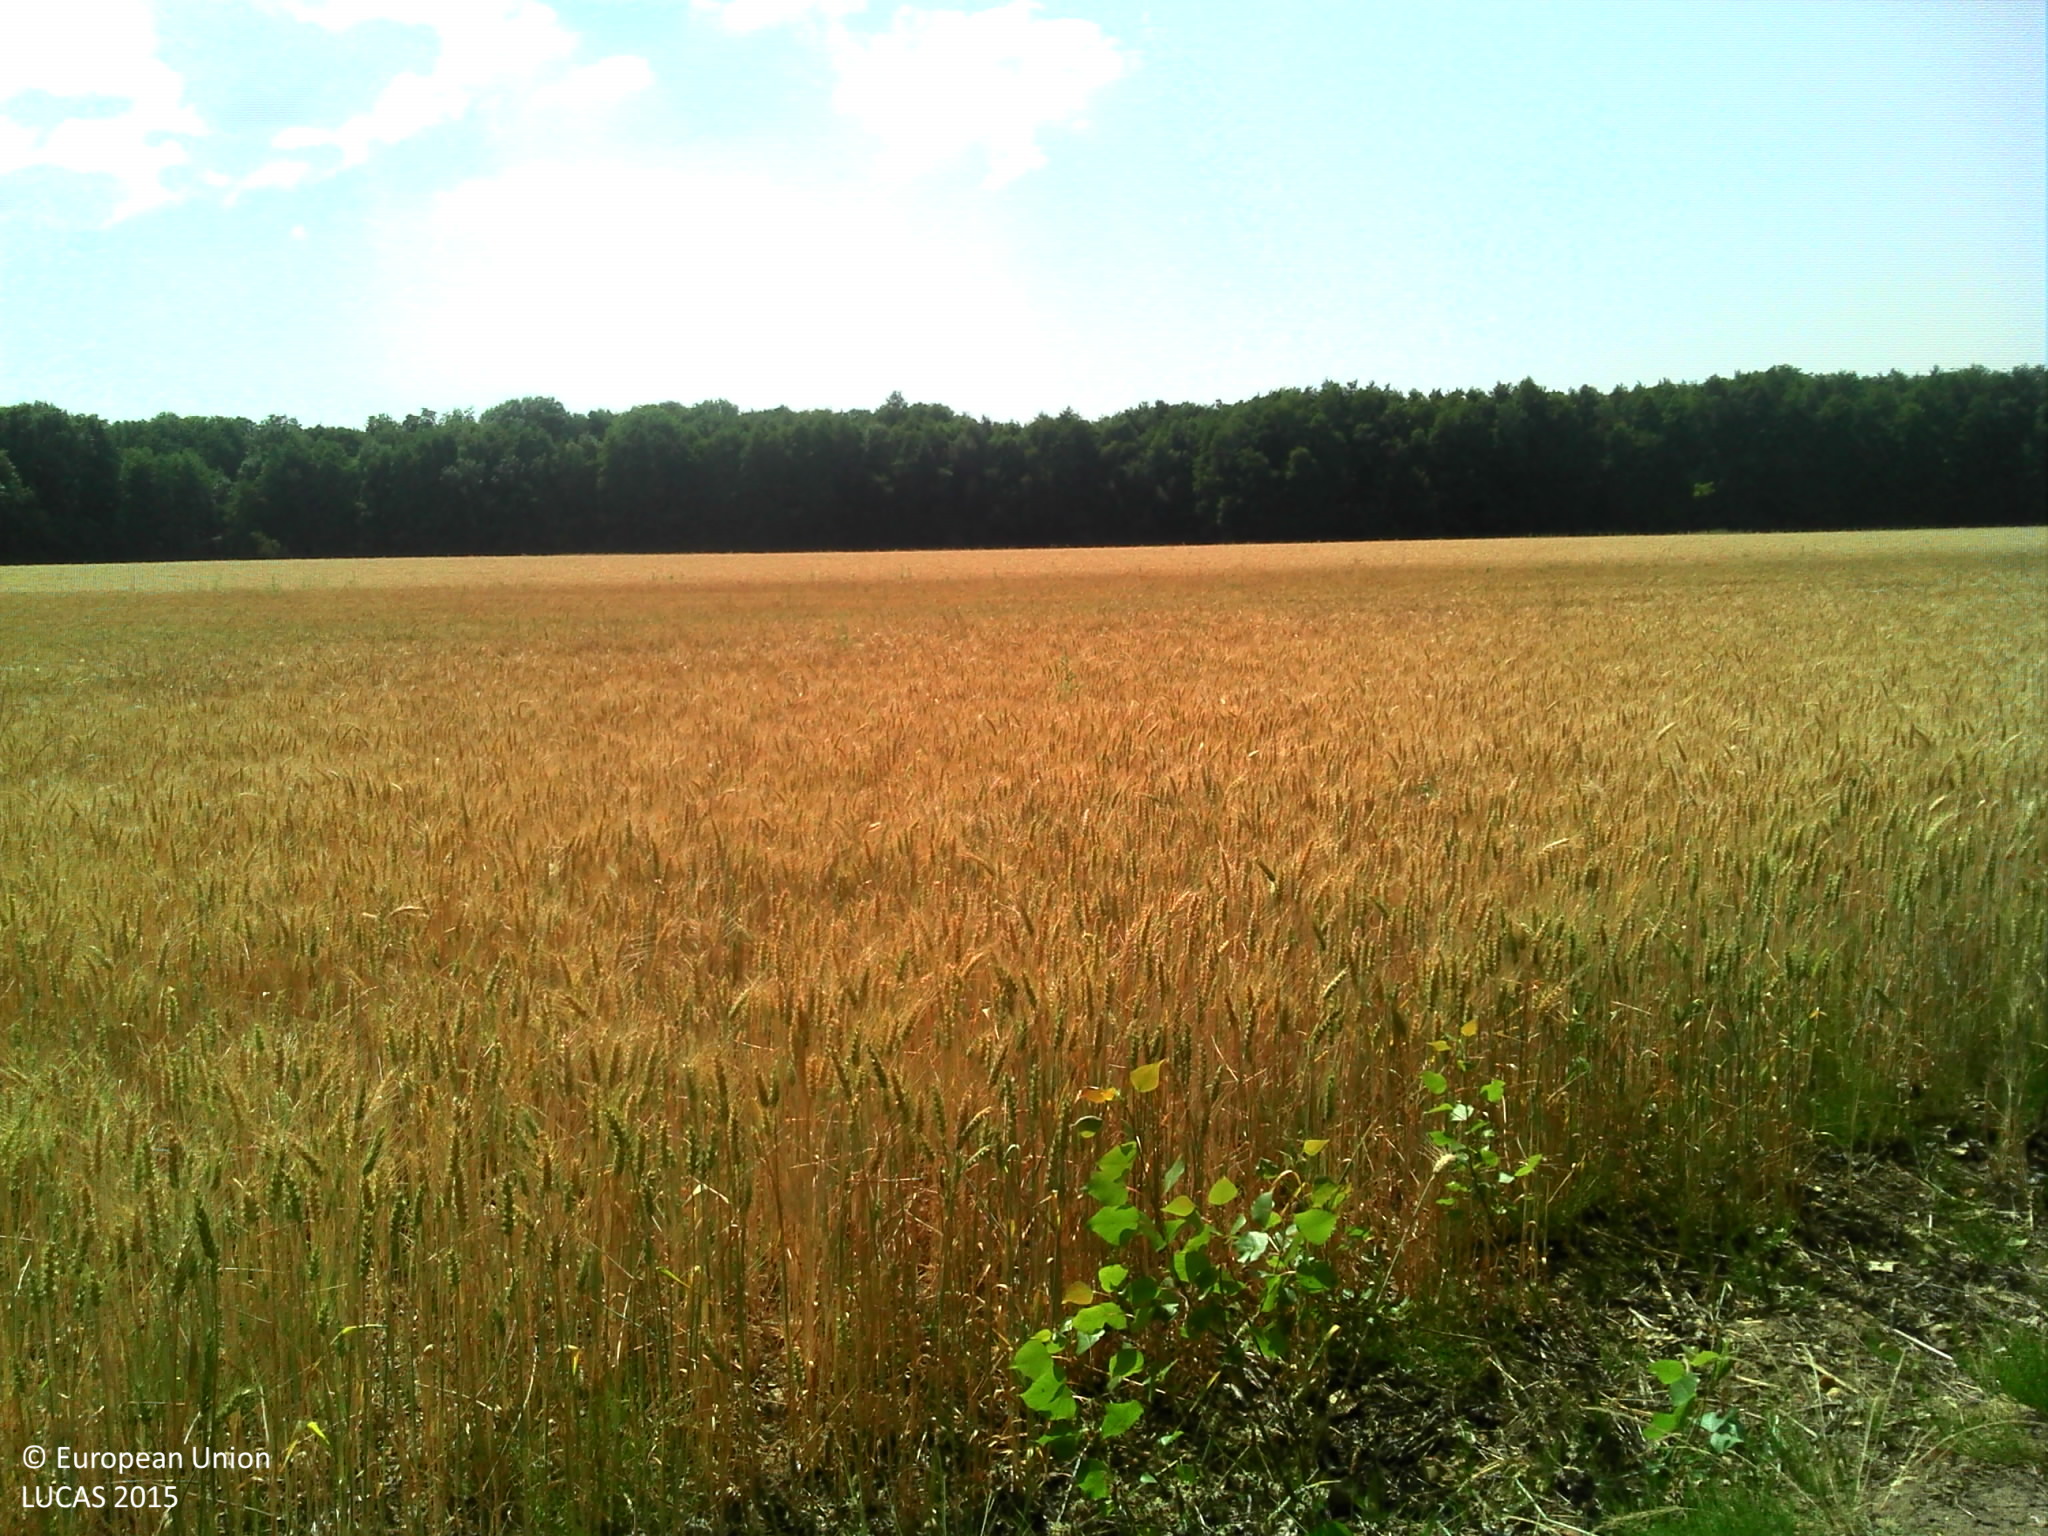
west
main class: Woodland
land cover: Broadleaved woodland
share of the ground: > 75 %
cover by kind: broadleaved forest trees 70 %, herbaceous plants 15 %, consolidated bare surface 15 %
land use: Semi-natural and natural areas not in use
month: July
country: FR
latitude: 48.8068
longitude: 1.3625
